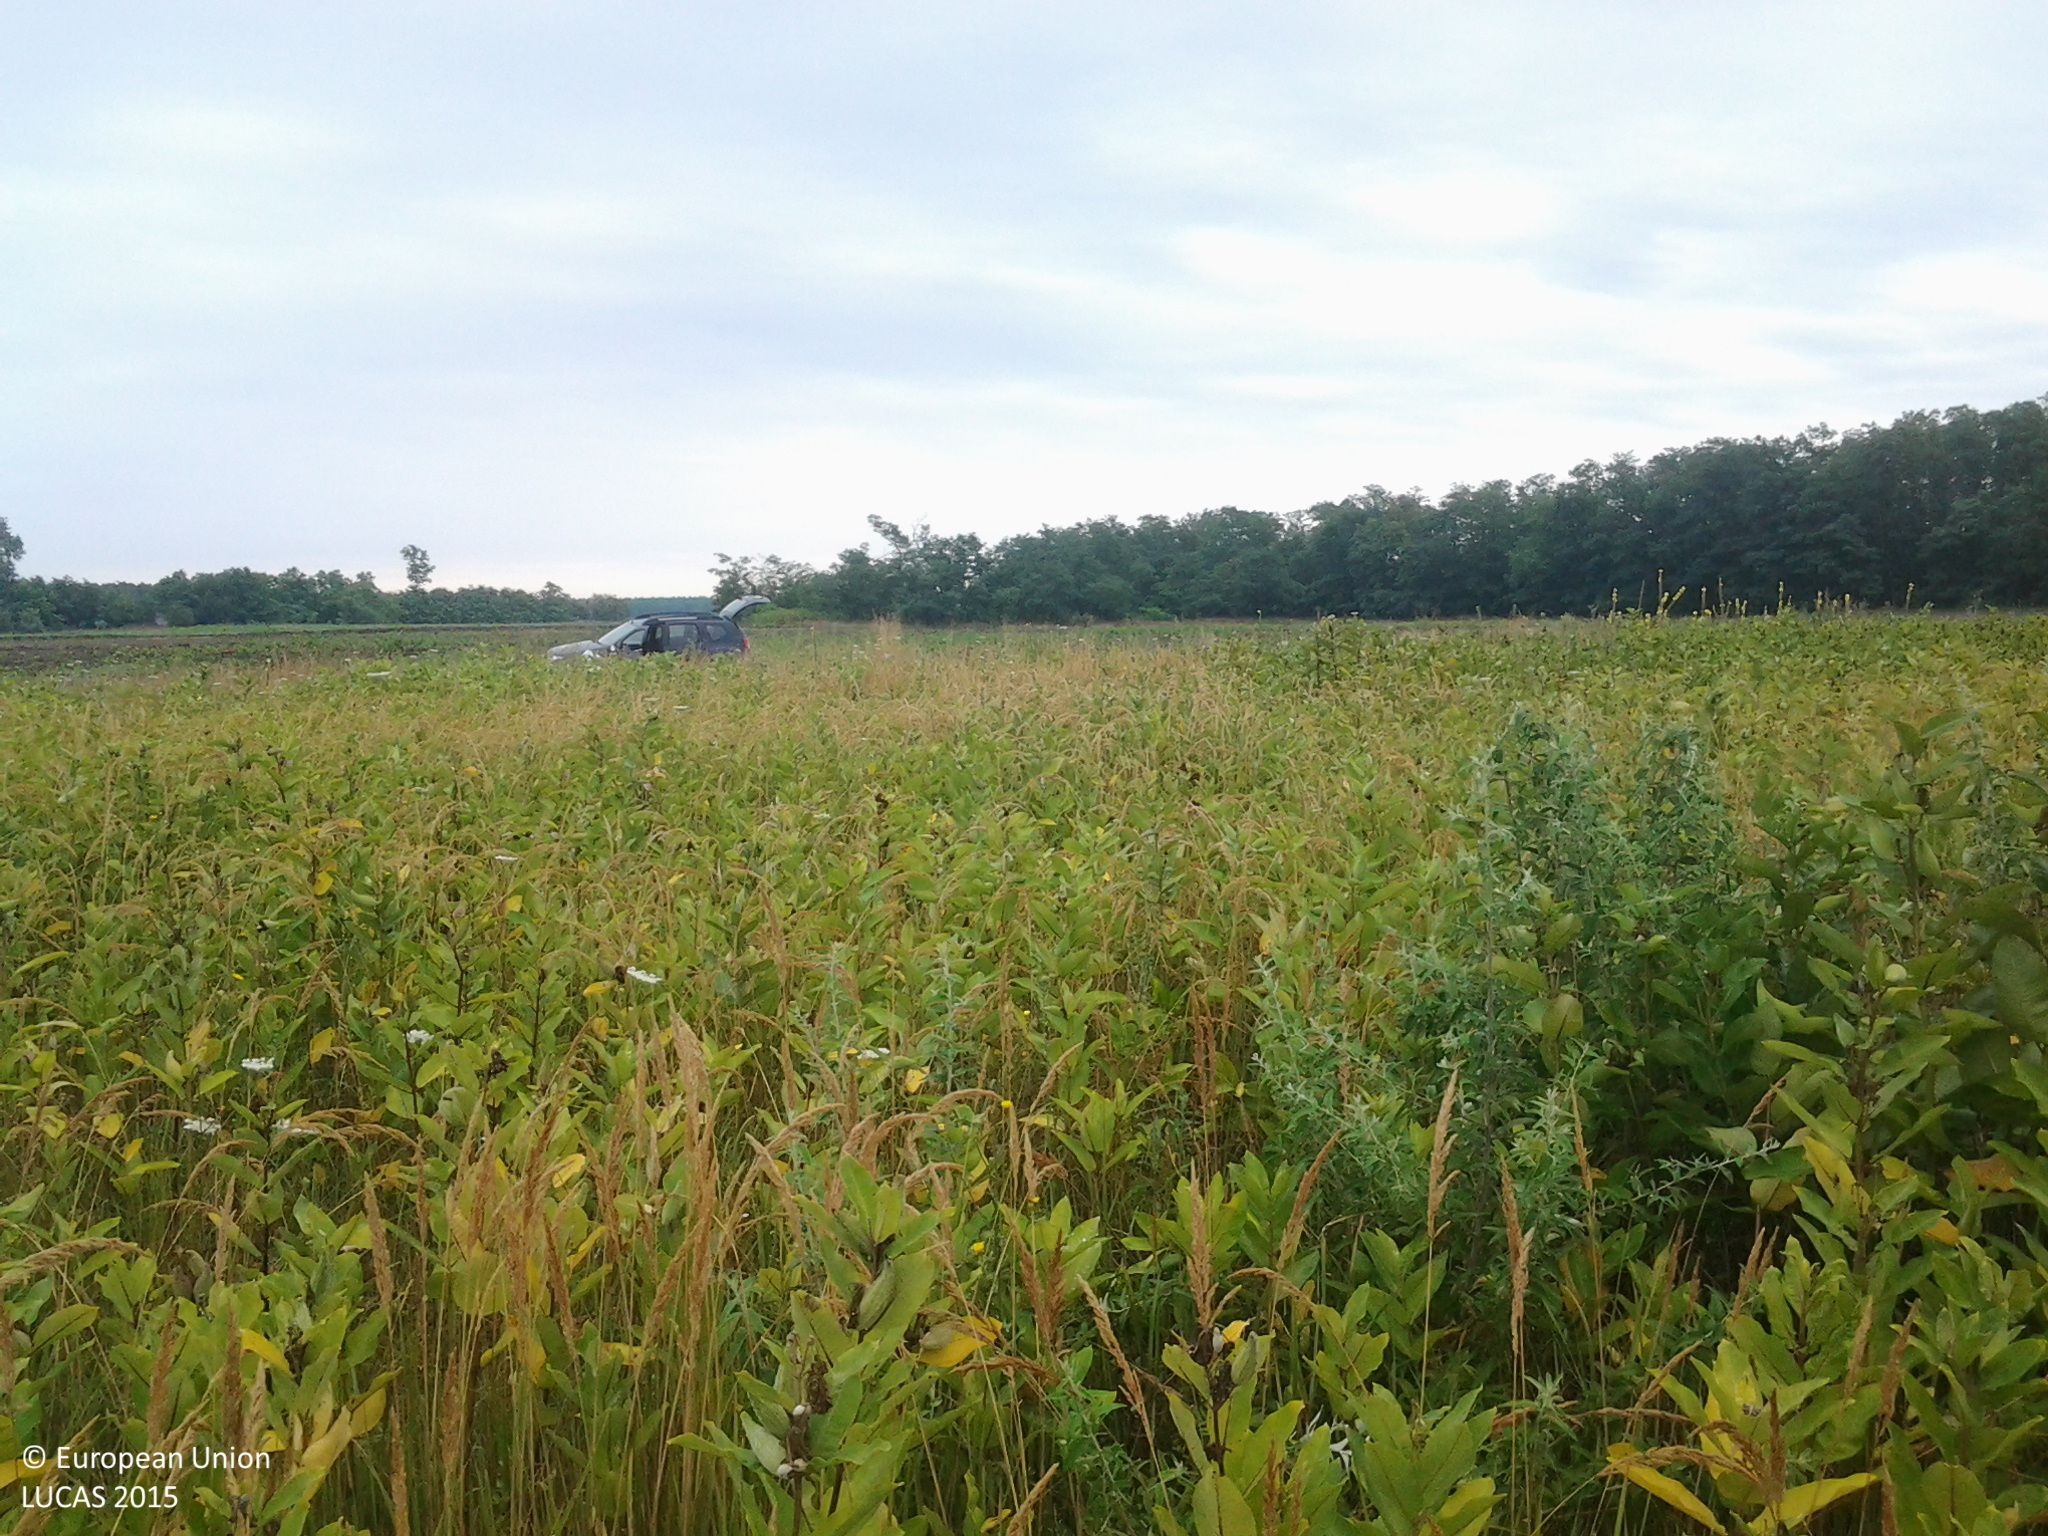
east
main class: Grassland
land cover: Spontaneously vegetated surfaces
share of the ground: > 75 %
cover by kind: herbaceous plants 100 %
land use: Semi-natural and natural areas not in use
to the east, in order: Spontaneously vegetated surfaces; Tracks; Grass margins; Tracks; Grass margins; Other bare soil; Grass margins; Tracks; Grass margins; Other bare soil; Broadleaved woodland; Grassland without tree/shrub cover
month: July
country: HU
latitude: 46.9282
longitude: 19.2501
